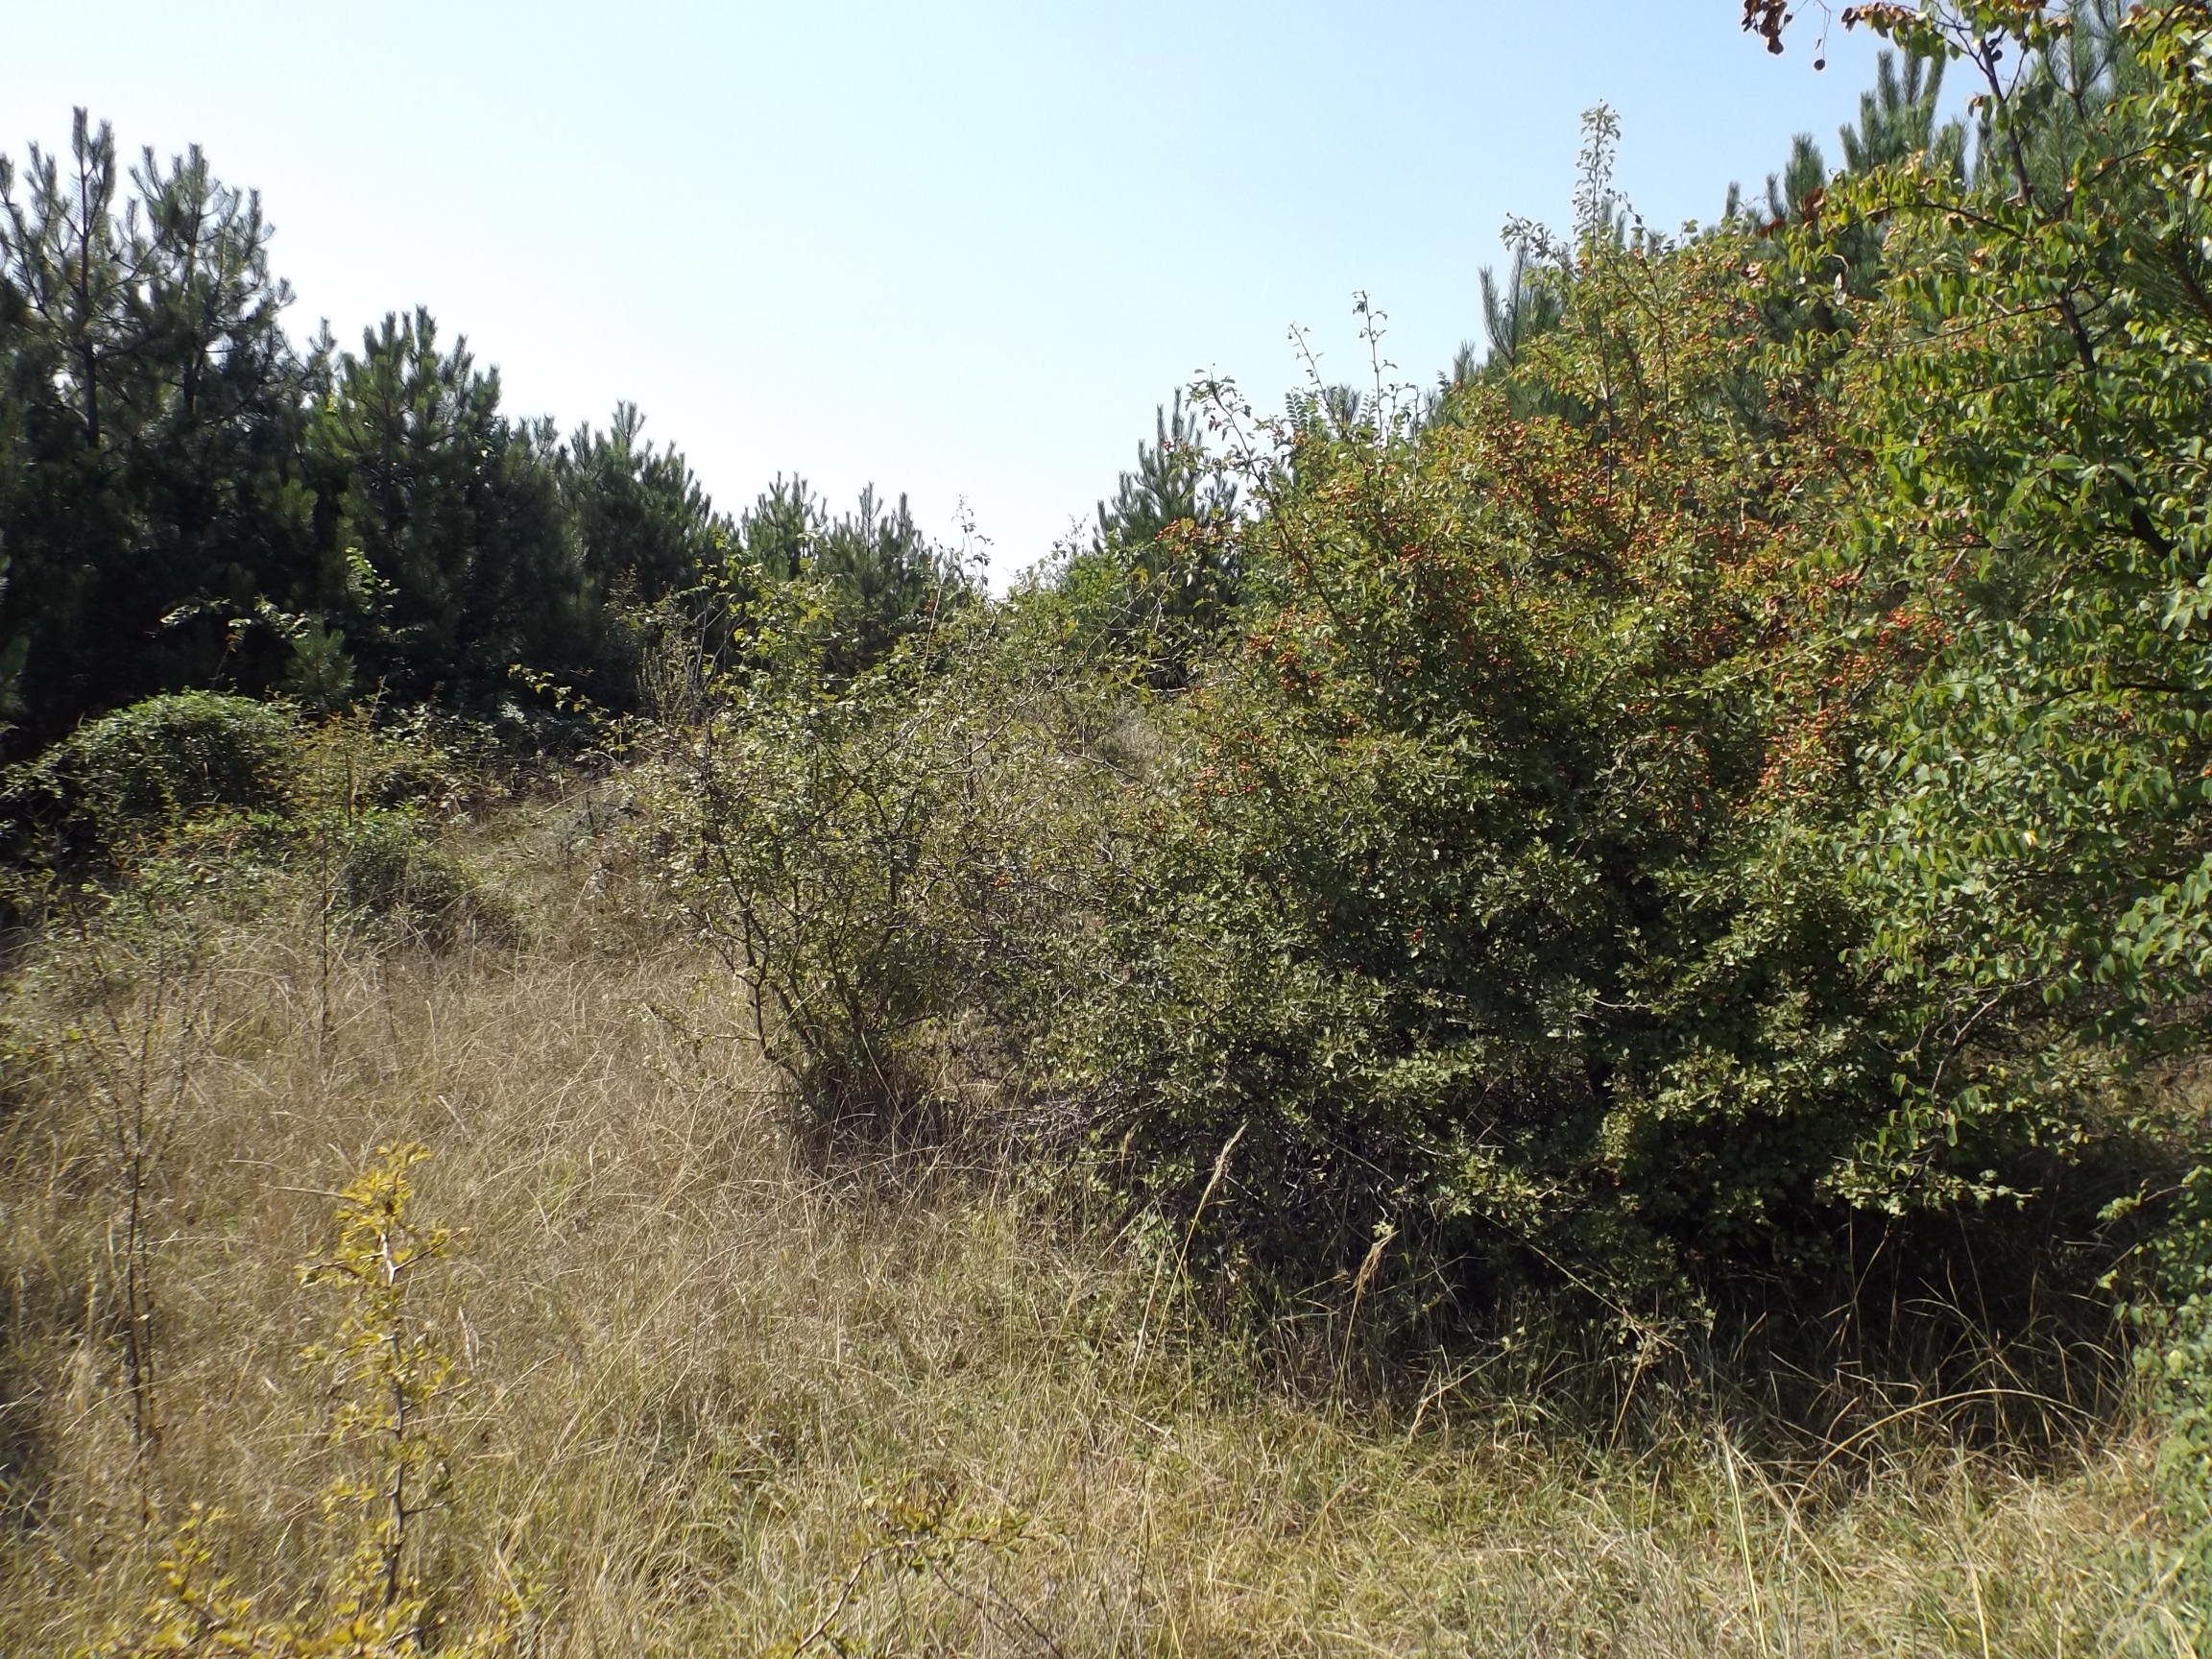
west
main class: Woodland
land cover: Pine dominated coniferous woodland
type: alpine coniferous forest
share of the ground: 50 - 75 %
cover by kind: coniferous forest trees 55 %, herbaceous plants 40 %, shrubs 5 %
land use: Forestry
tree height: < 5 m
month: August
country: BG
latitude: 43.0906
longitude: 27.3827
